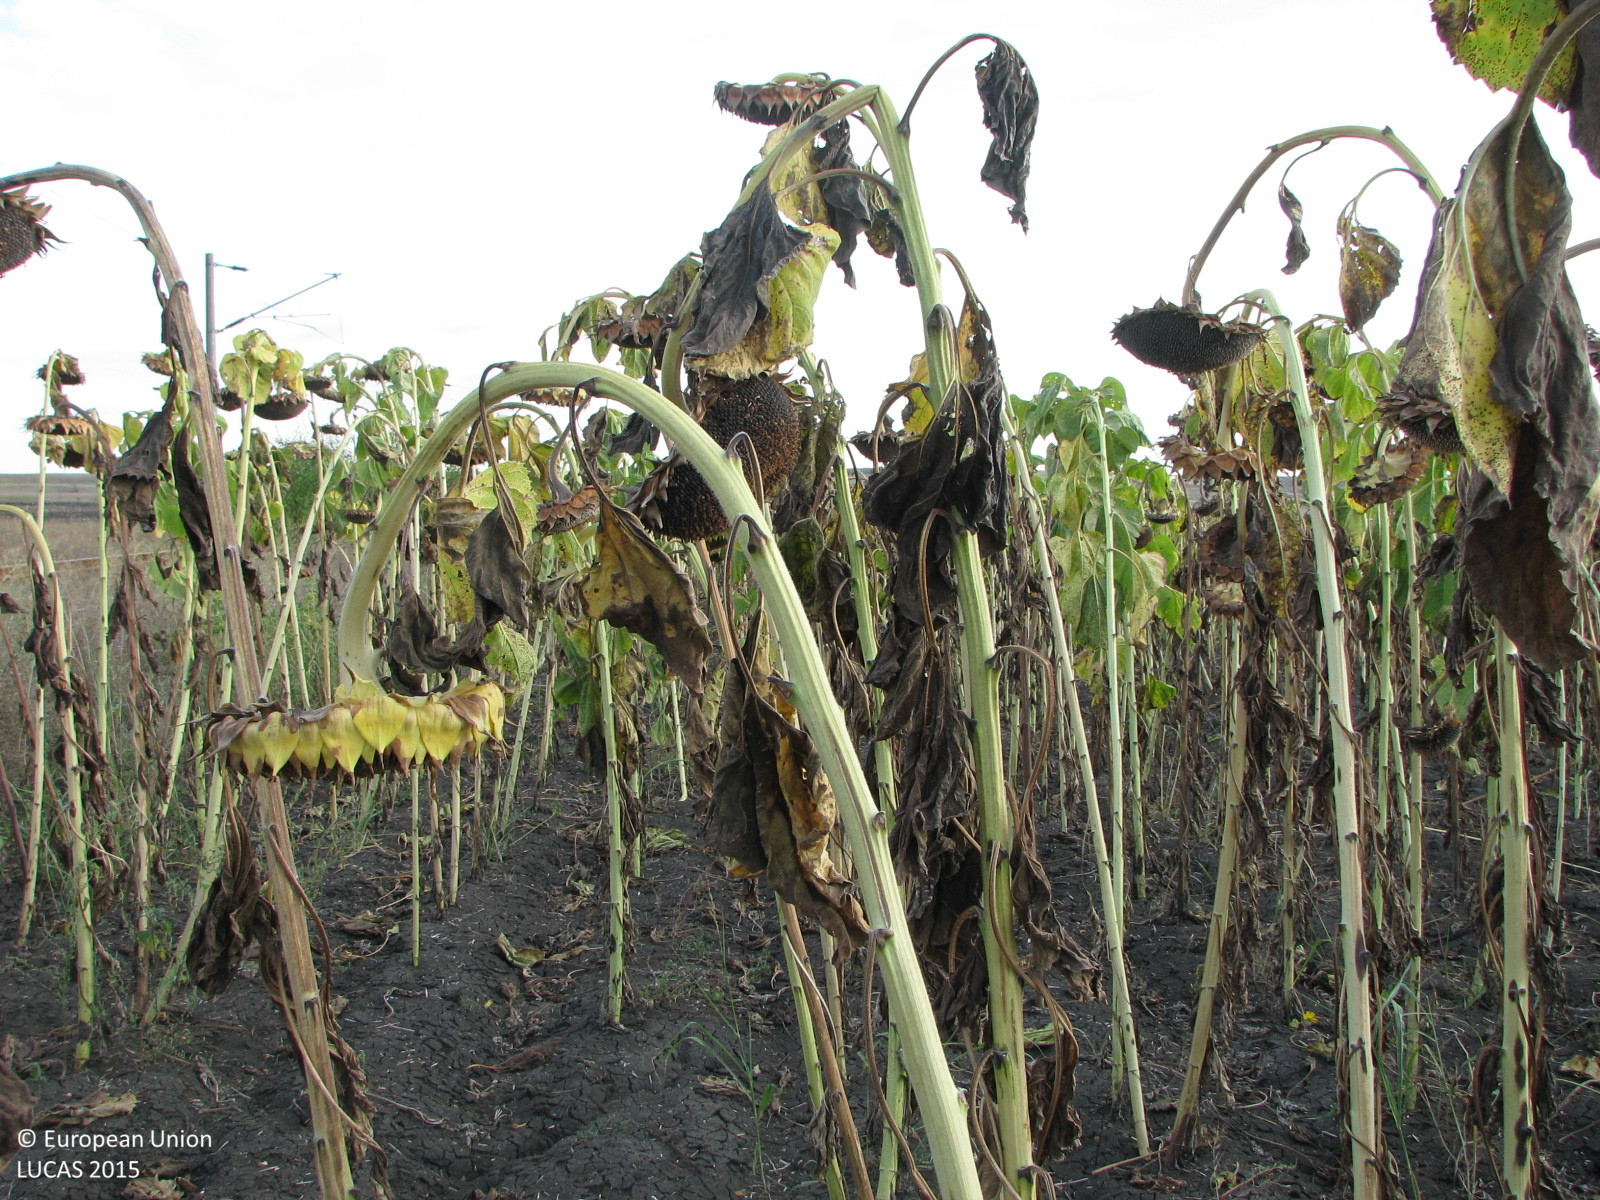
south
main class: Cropland
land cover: Common wheat
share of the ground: > 75 %
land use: Agriculture (excluding fallow land and kitchen gardens)
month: September
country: BG
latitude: 42.2831
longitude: 26.0501
